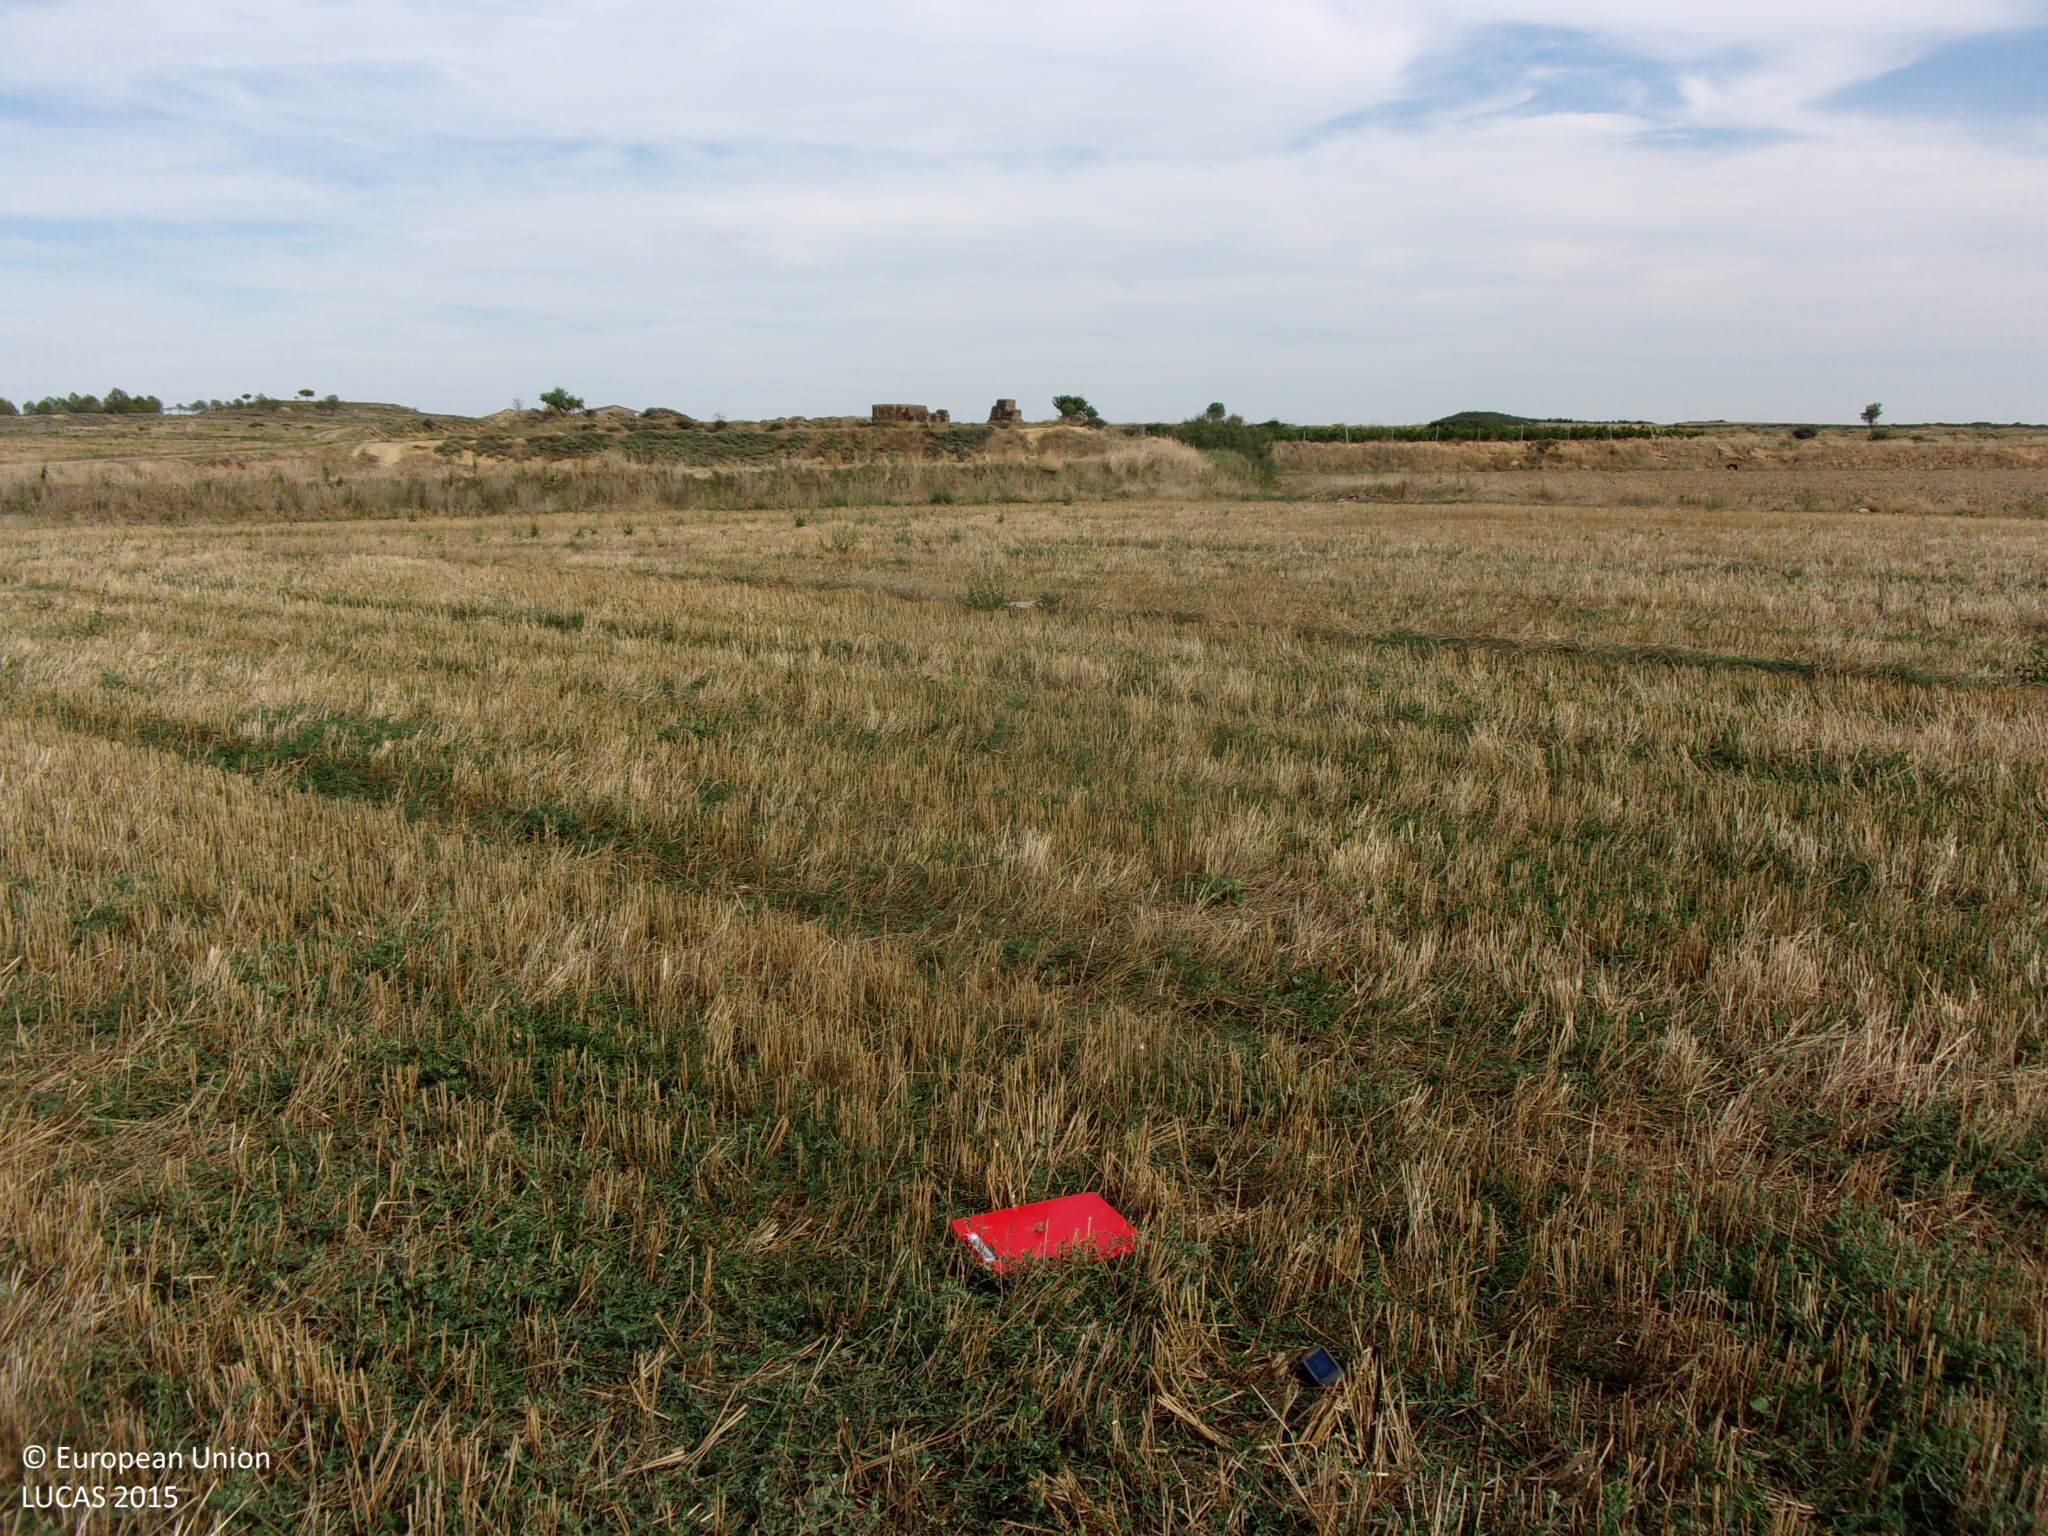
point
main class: Cropland
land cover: Durum wheat
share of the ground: < 10 %
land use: Agriculture (excluding fallow land and kitchen gardens)
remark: Harvested field
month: August
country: ES
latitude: 42.2199
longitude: -1.1381
